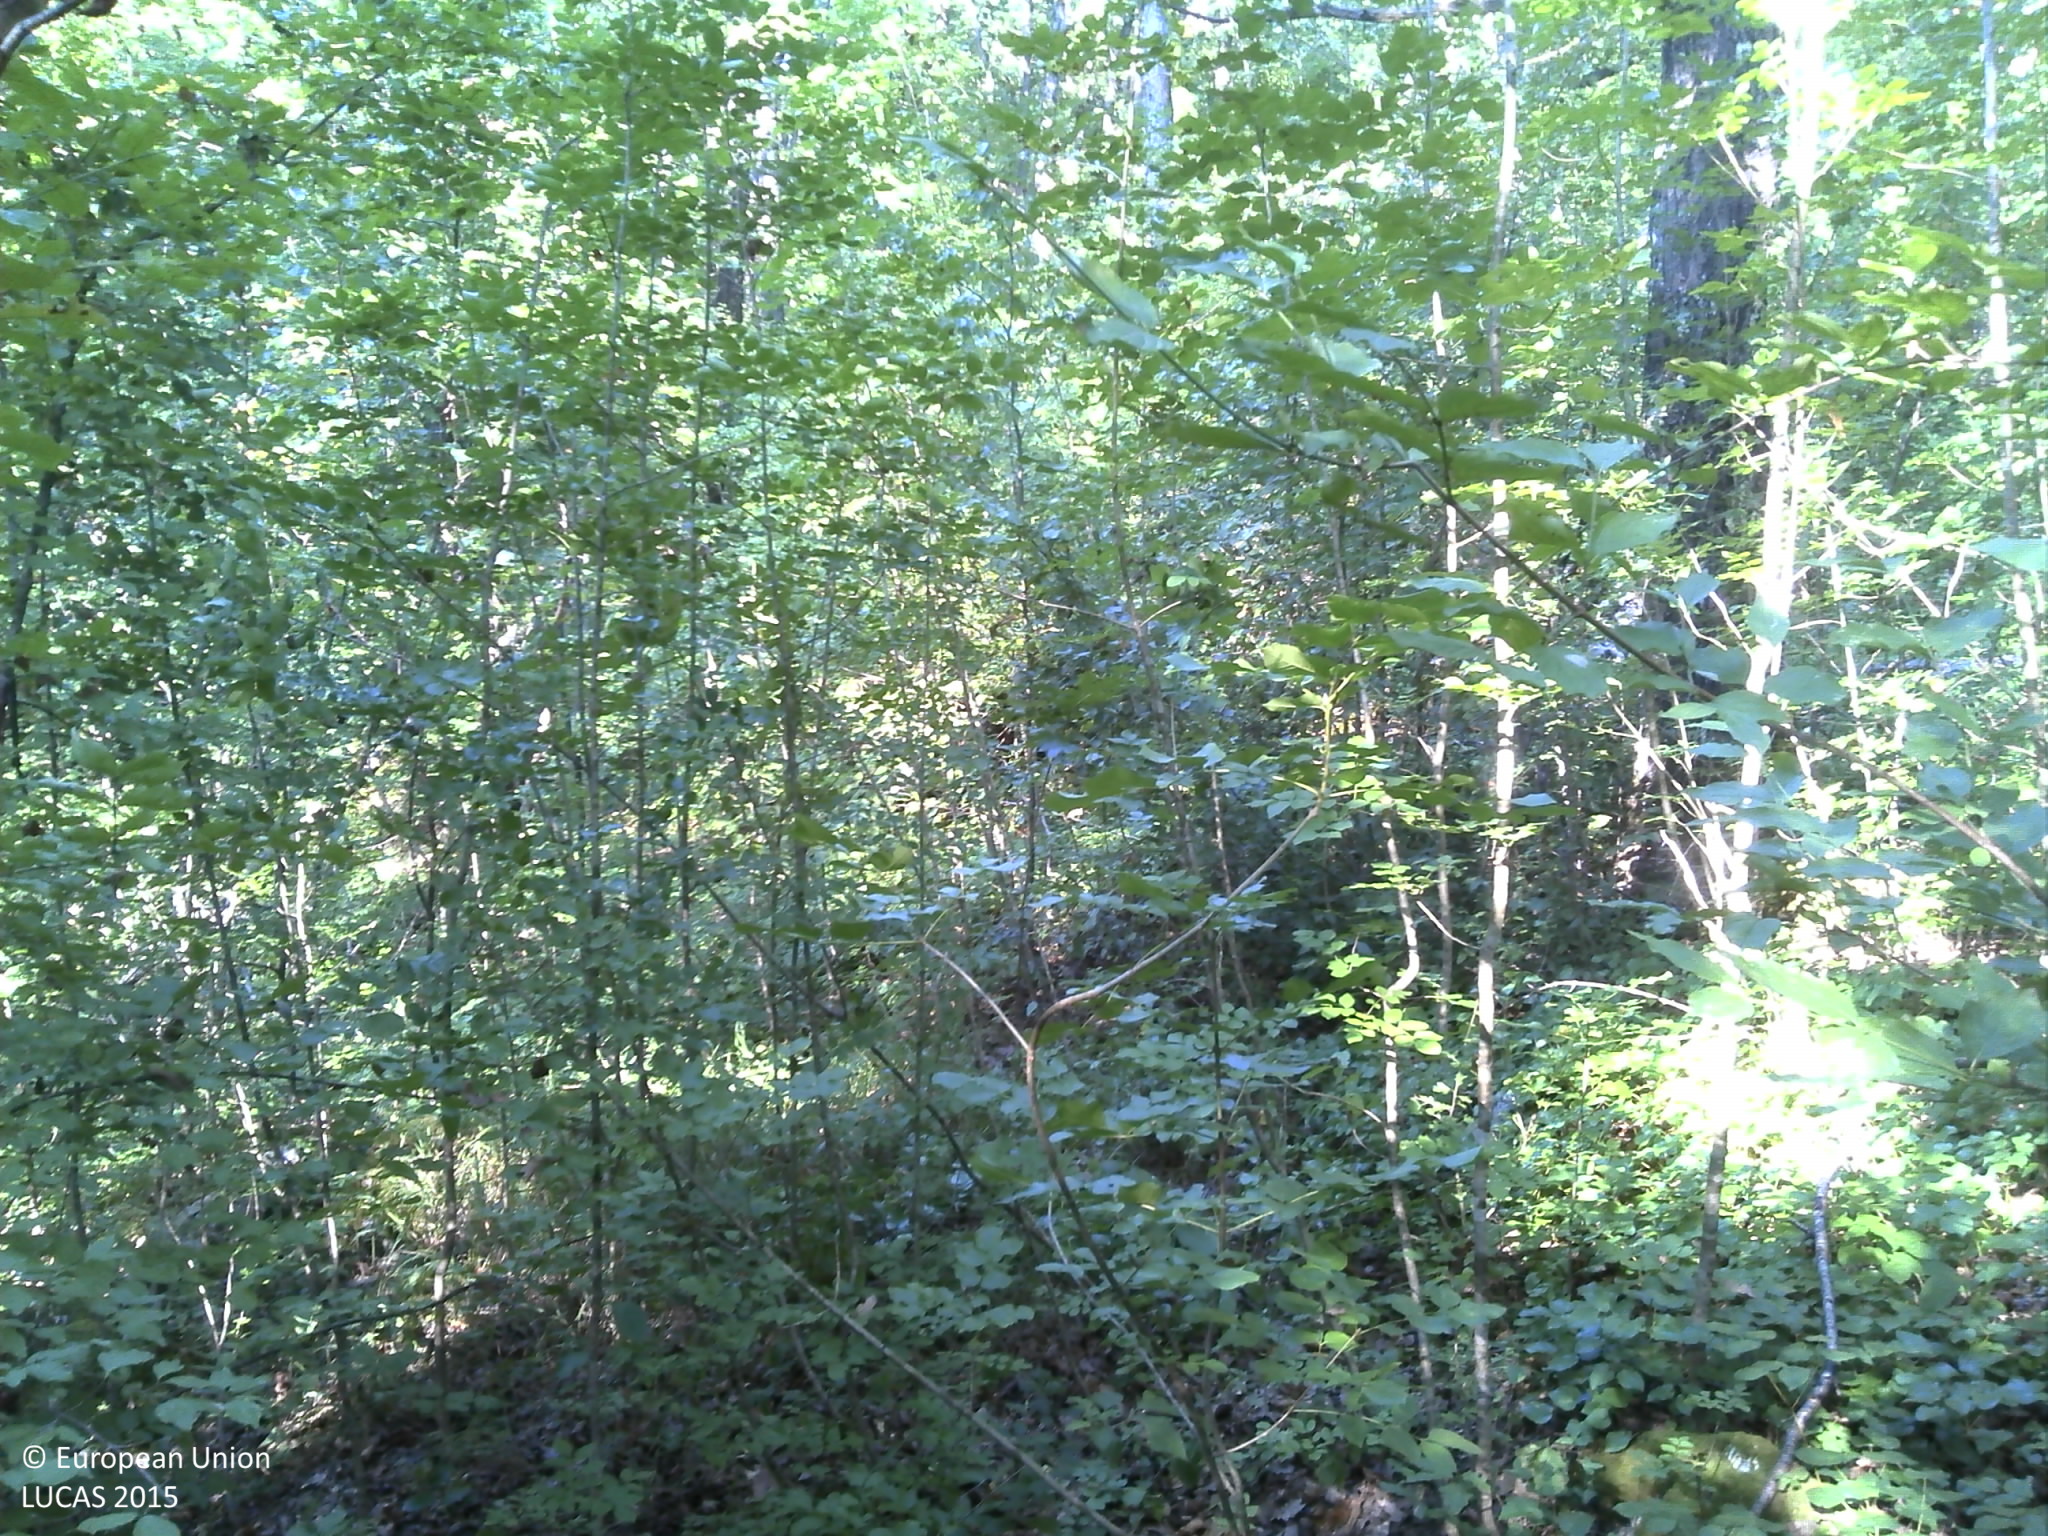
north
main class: Woodland
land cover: Broadleaved woodland
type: acidophilous oak and oak-birch forest
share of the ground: > 75 %
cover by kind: broadleaved forest trees 100 %
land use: Forestry
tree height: > 5 m
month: September
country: HR
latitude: 45.3356
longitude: 15.2912
